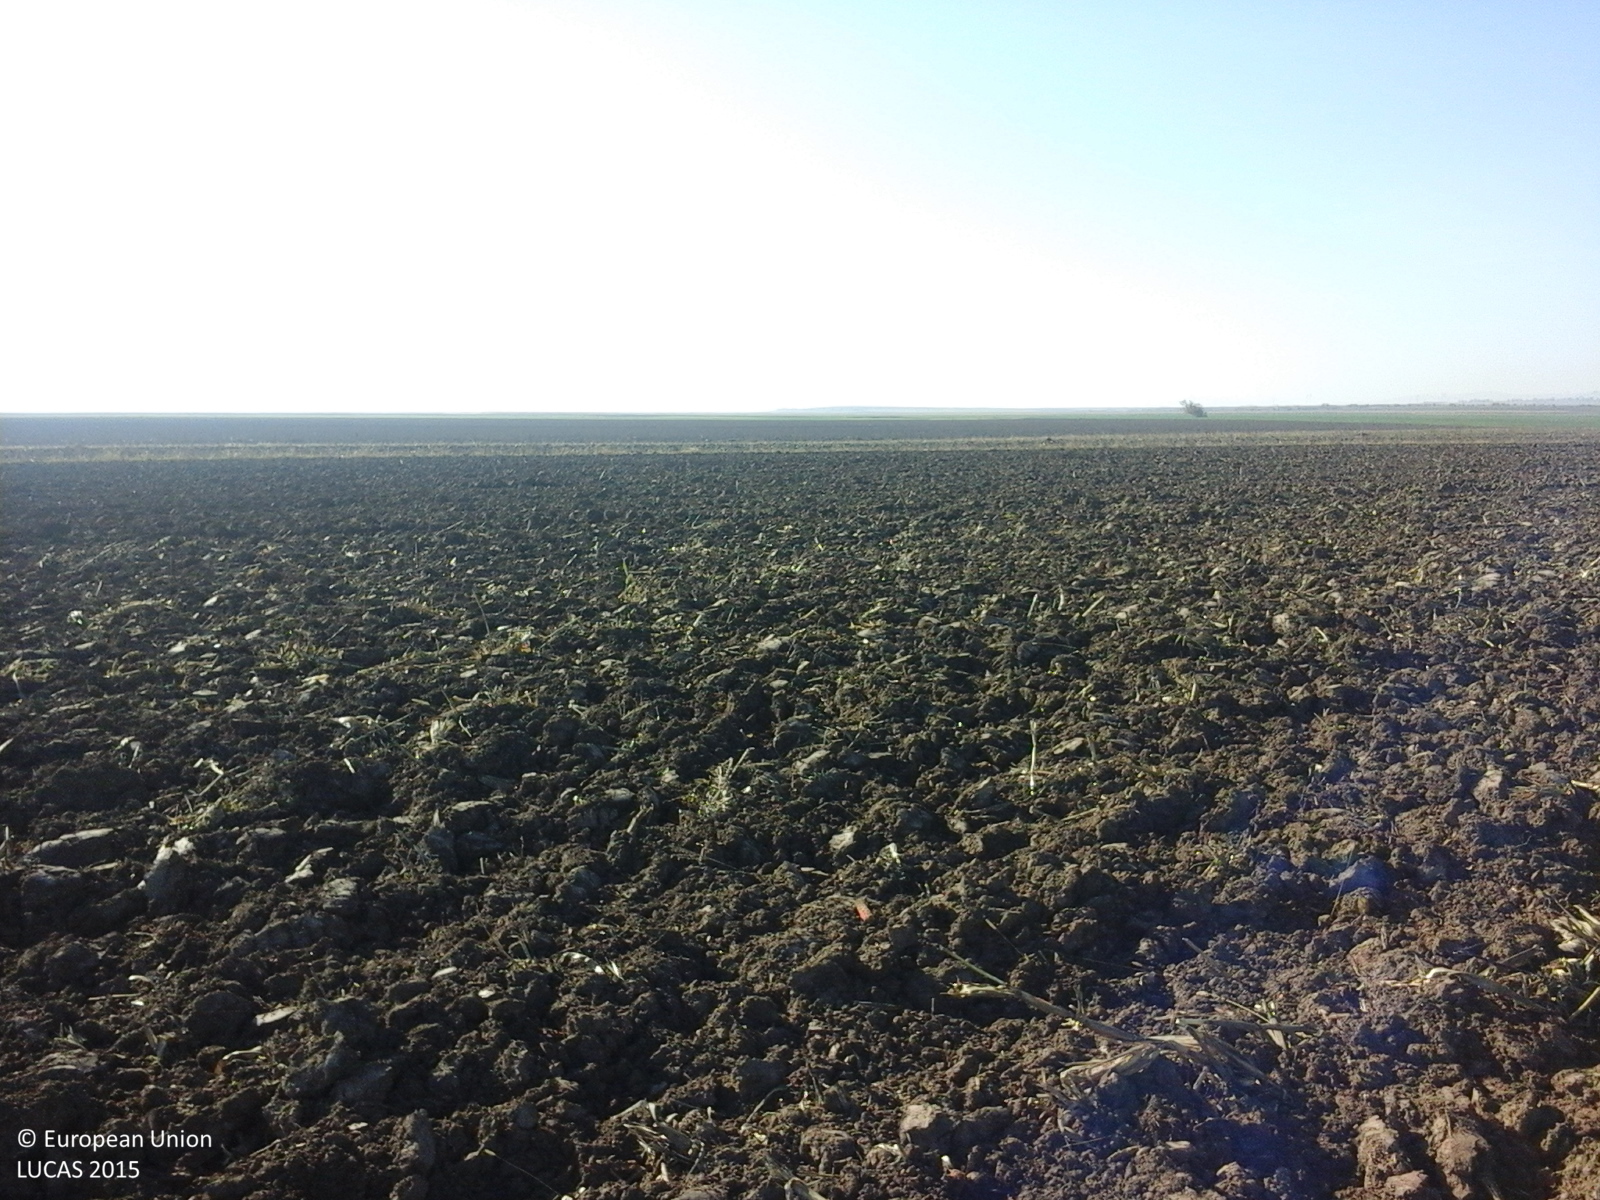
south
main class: Cropland
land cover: Maize
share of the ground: < 10 %
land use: Agriculture (excluding fallow land and kitchen gardens)
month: October
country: RO
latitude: 45.9575
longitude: 27.1931
